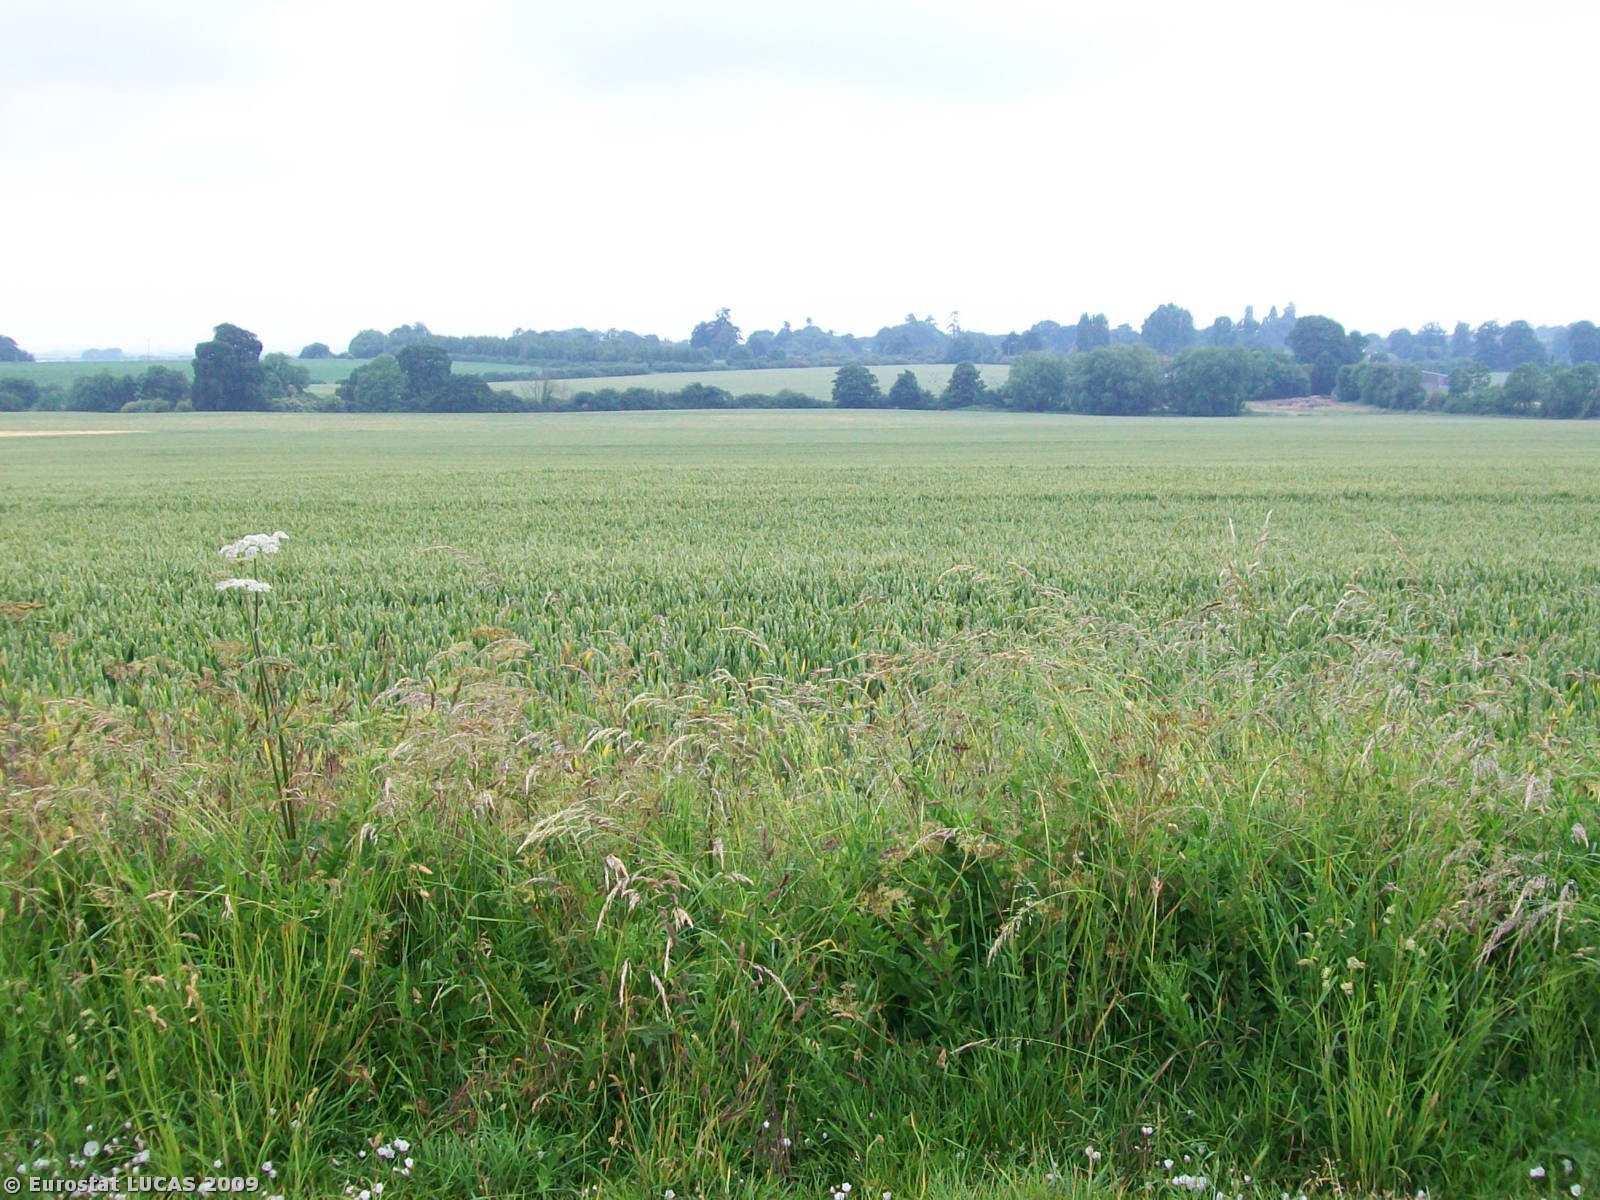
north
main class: Cropland
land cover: Common wheat
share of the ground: > 75 %
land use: Agriculture (excluding fallow land and kitchen gardens)
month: June
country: GB
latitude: 51.2368
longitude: -2.1929
